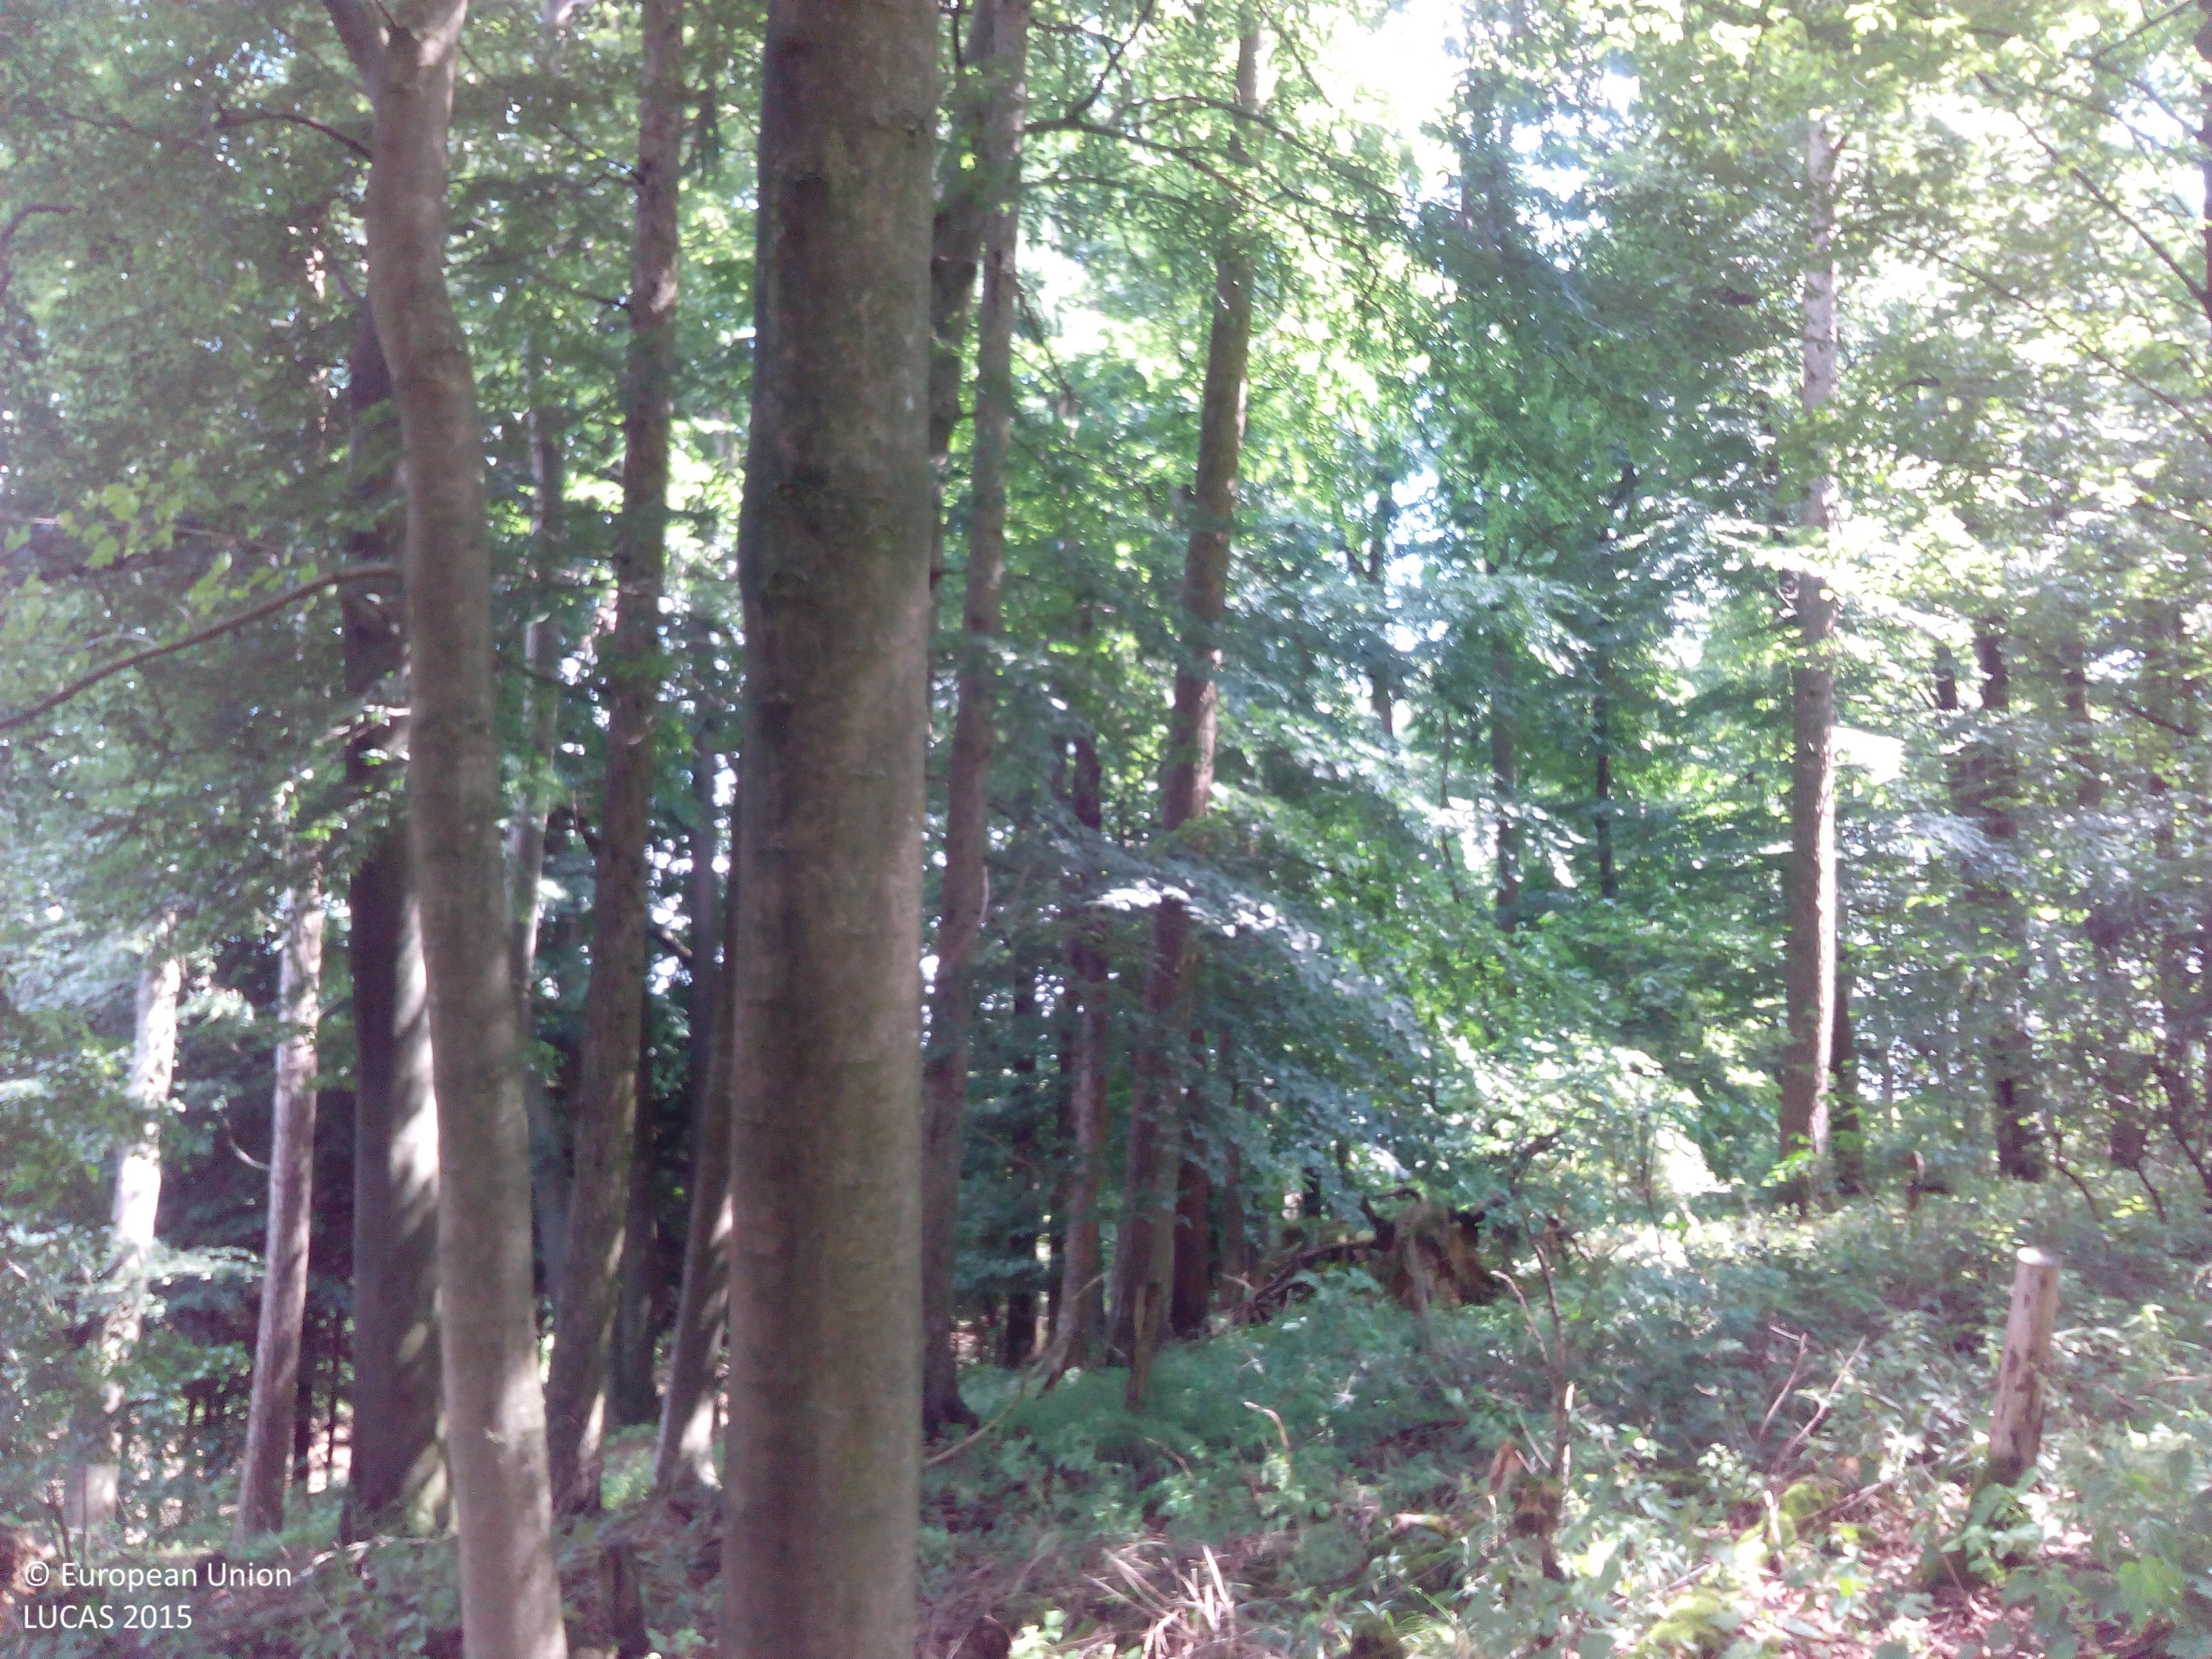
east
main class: Woodland
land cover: Broadleaved woodland
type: mesophytic deciduous forest
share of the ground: > 75 %
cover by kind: broadleaved forest trees 90 %, shrubs 5 %, herbaceous plants 5 %
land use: Forestry
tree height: > 5 m
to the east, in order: Broadleaved woodland; Fences; Grassland without tree/shrub cover; Fences; Tracks; Fences; Grassland with sparse tree/shrub cover; Fences; Grassland without tree/shrub cover
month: July
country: DE
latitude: 52.2172
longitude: 8.0245
